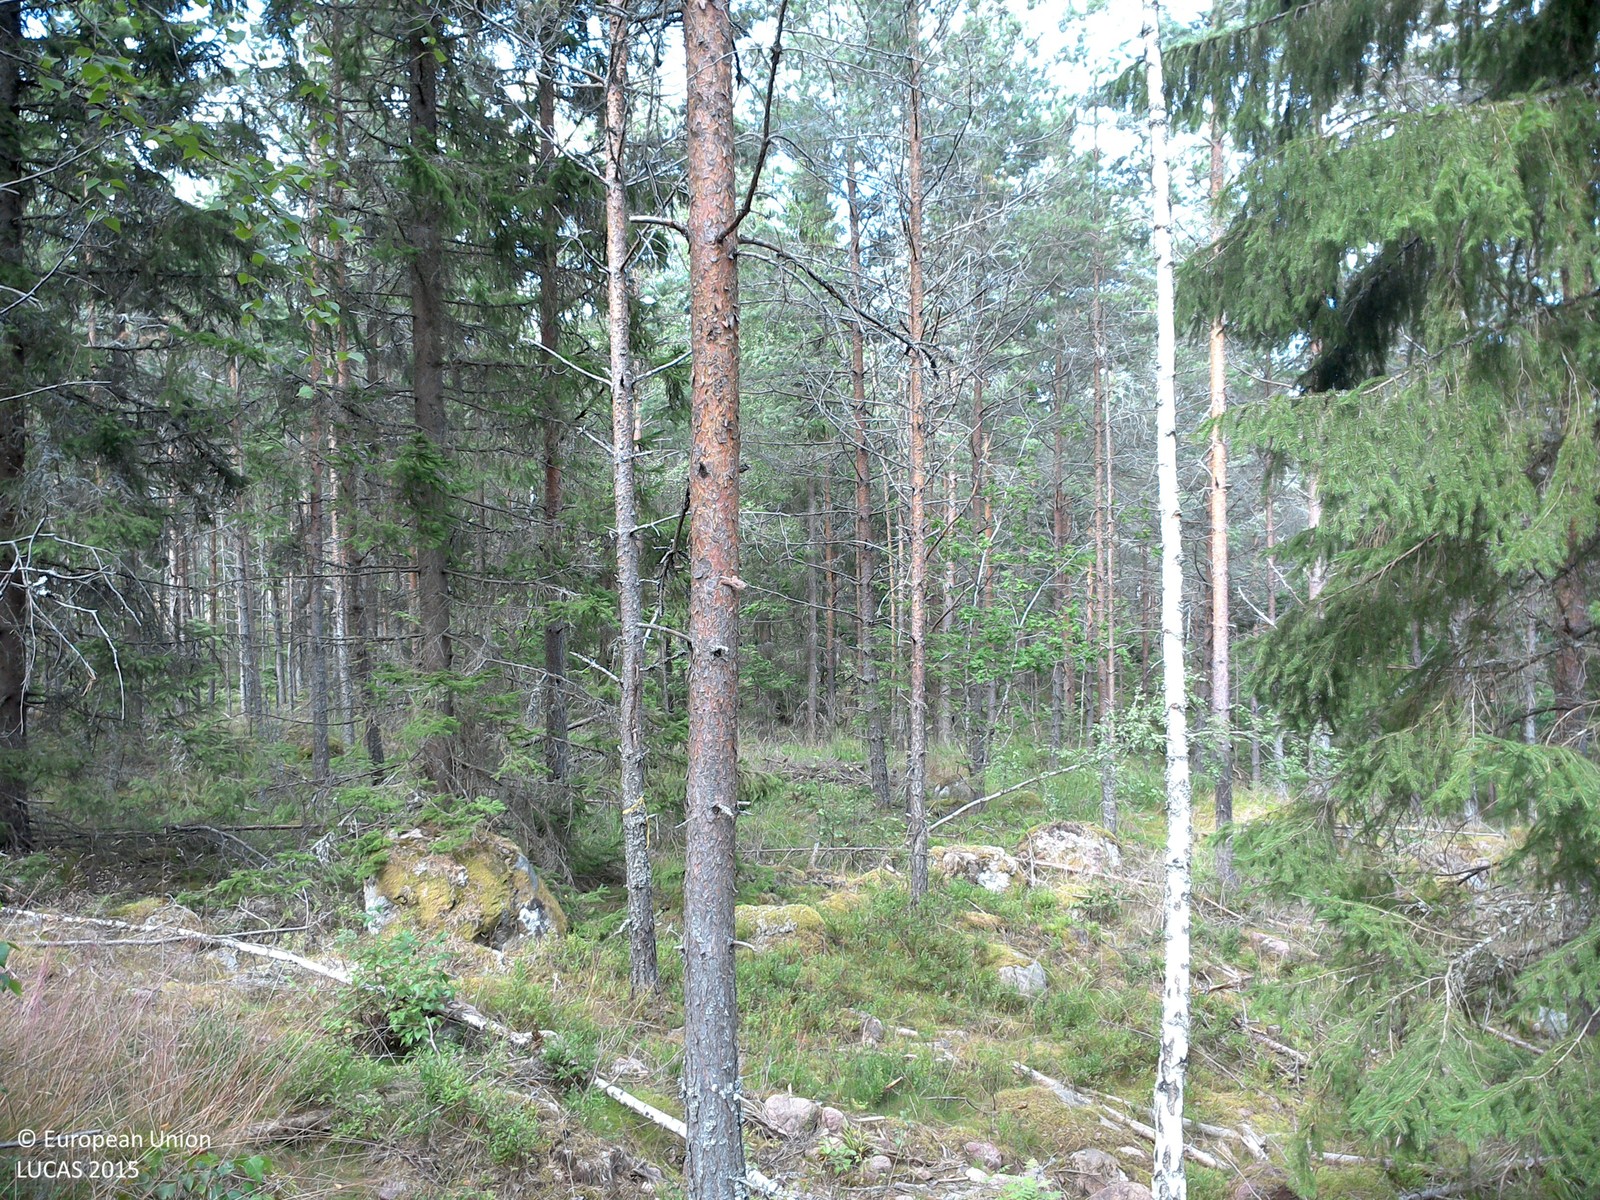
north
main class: Woodland
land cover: Pine dominated coniferous woodland
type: boreal forest
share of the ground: 25 - 50 %
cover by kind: lichens and mosses 50 %, coniferous forest trees 40 %, herbaceous plants 10 %
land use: Forestry
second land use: Amenities, museums, leisure
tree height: > 5 m
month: August
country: SE
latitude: 58.1456
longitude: 14.9721
